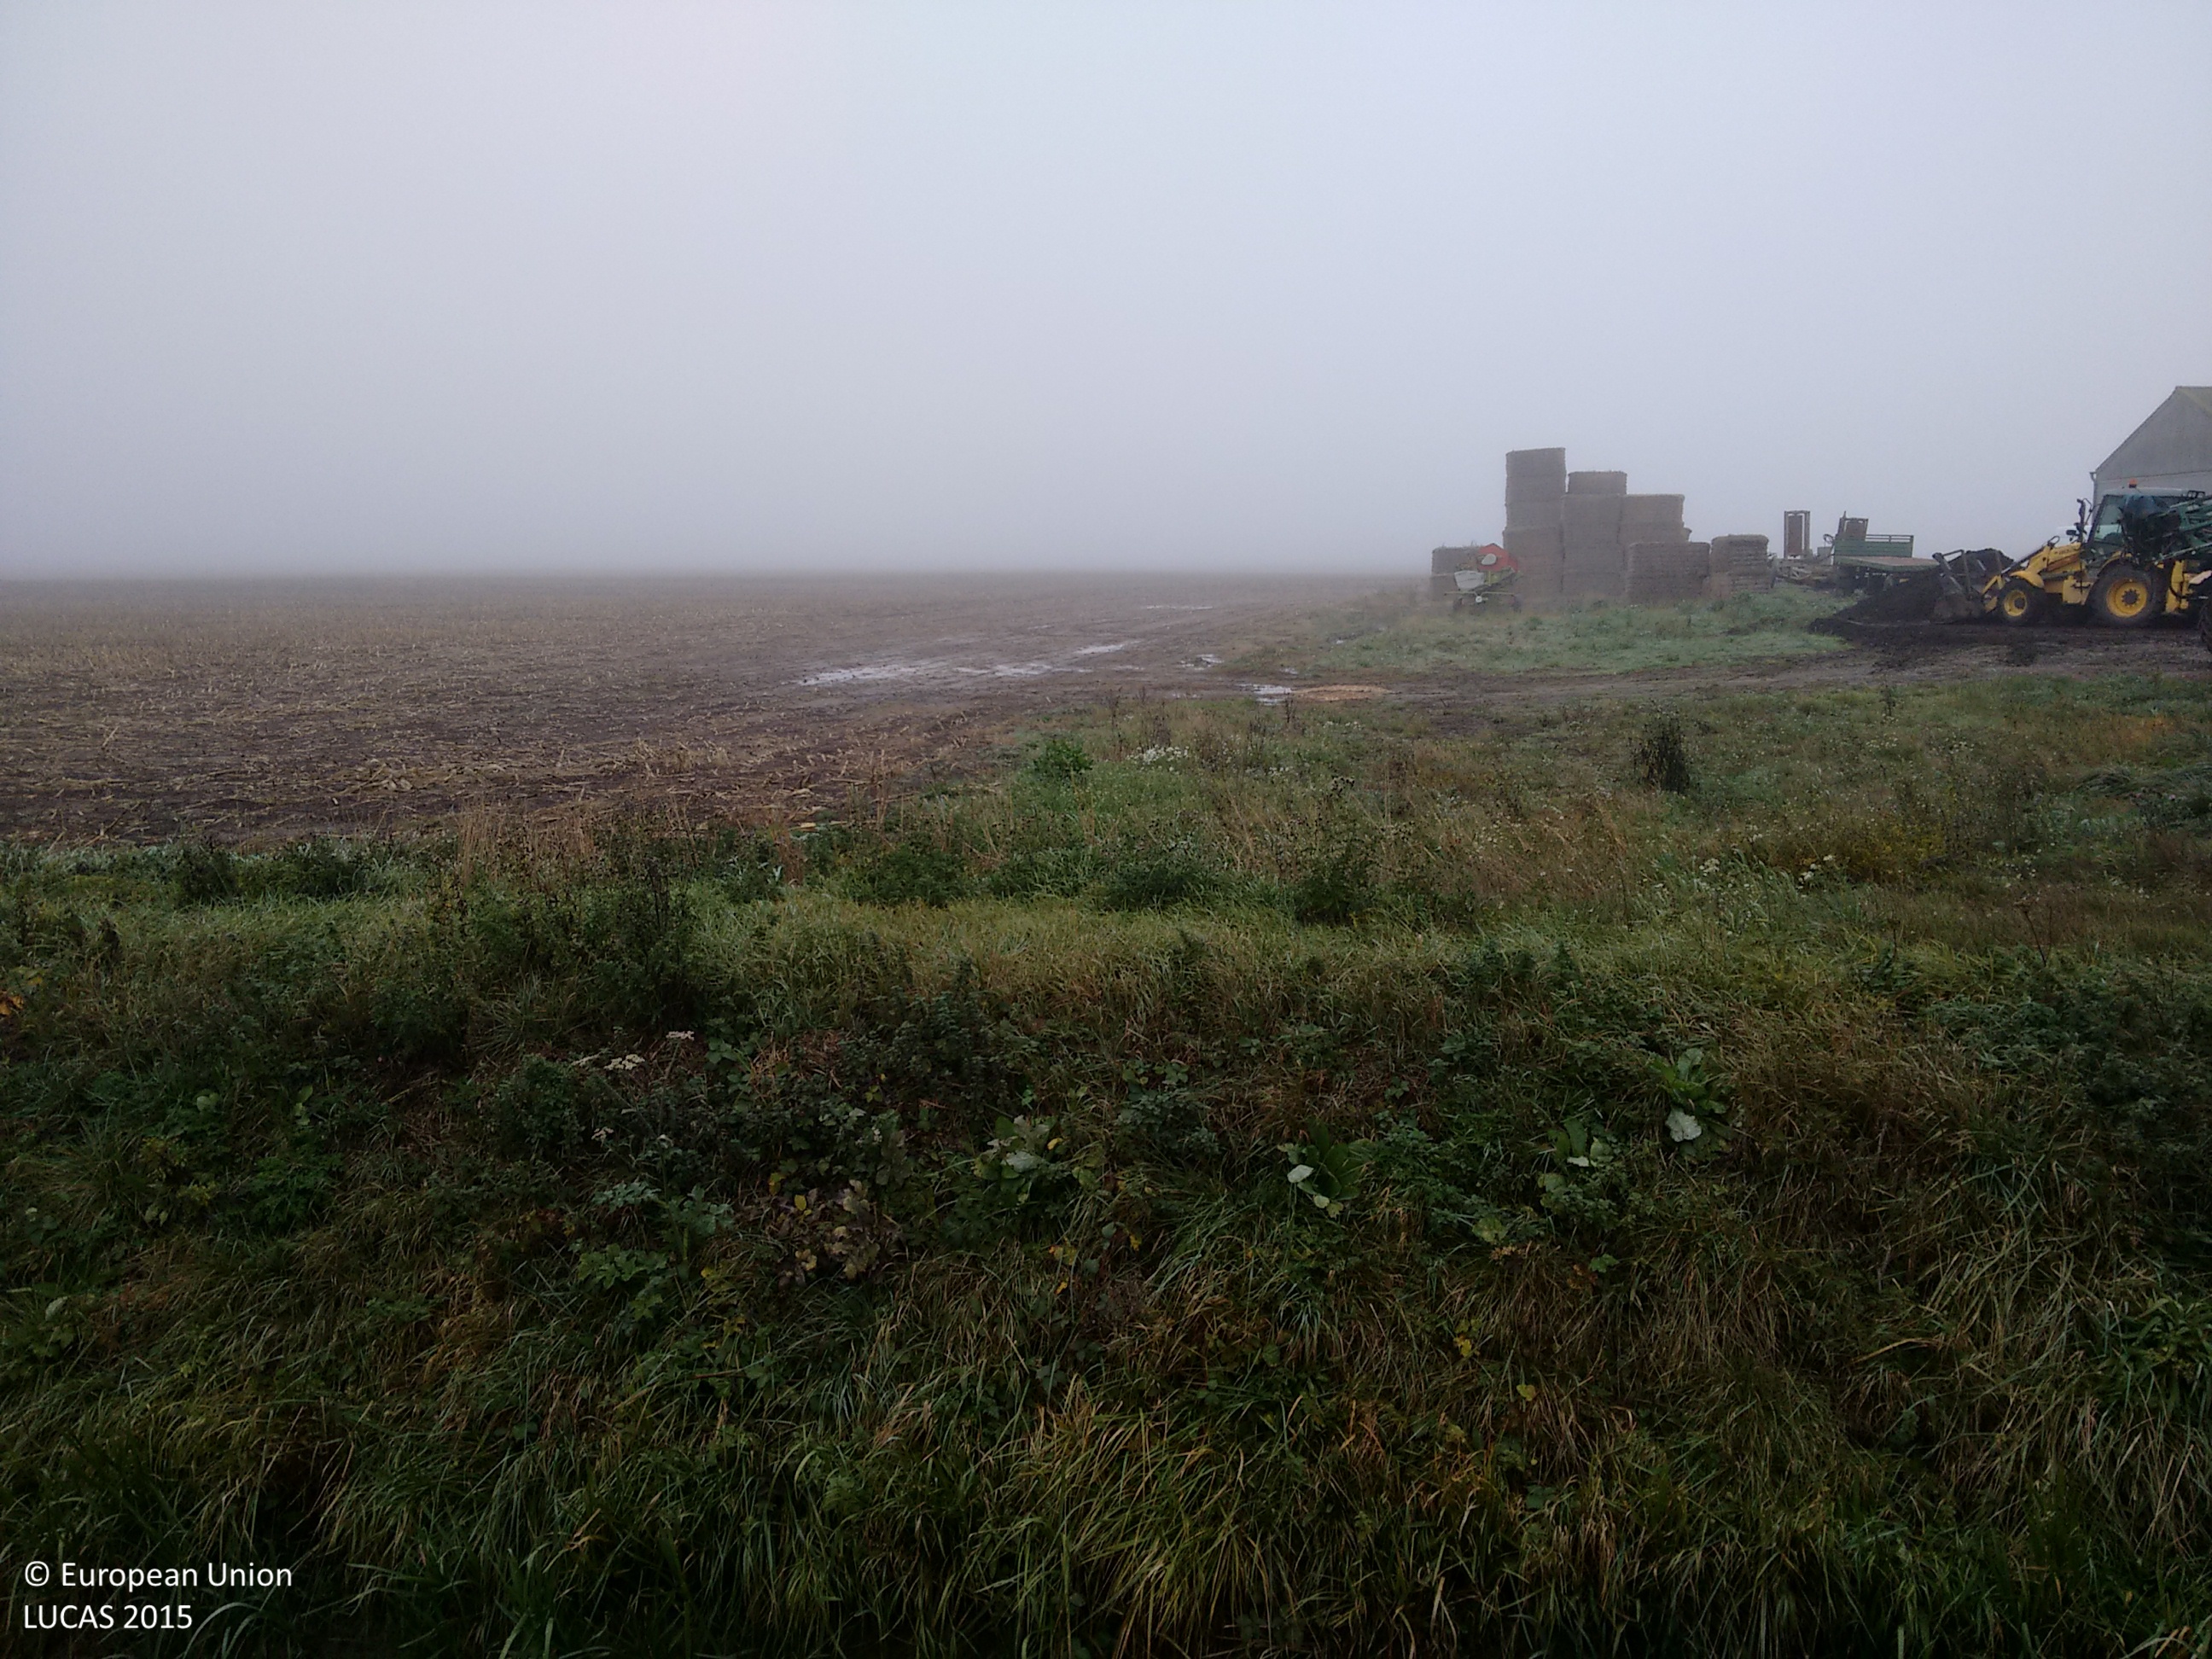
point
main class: Cropland
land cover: Maize
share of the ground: > 75 %
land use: Agriculture (excluding fallow land and kitchen gardens)
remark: Harvested field
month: November
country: GB
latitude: 53.0939
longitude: -0.0225
